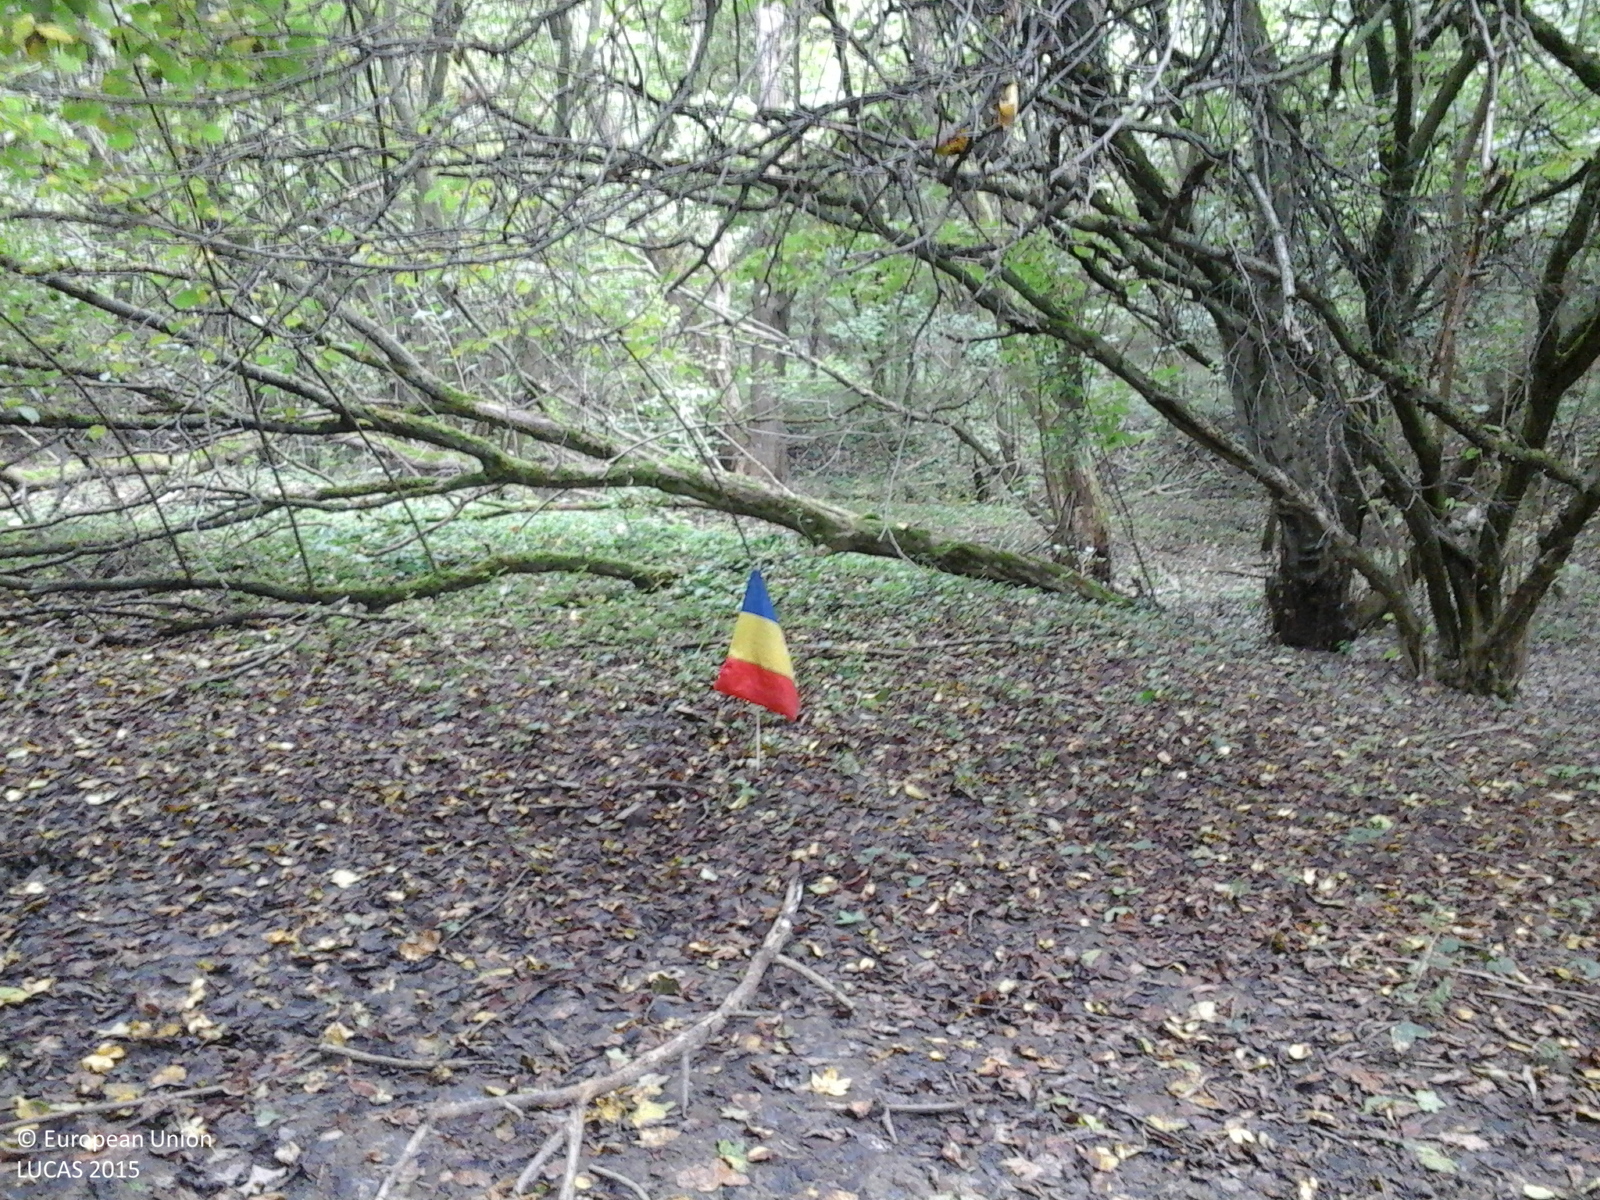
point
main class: Woodland
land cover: Broadleaved woodland
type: mesophytic deciduous forest
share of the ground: > 75 %
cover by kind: broadleaved forest trees 100 %
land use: Forestry
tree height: > 5 m
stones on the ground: < 10 %
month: October
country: RO
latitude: 46.3907
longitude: 24.5610
